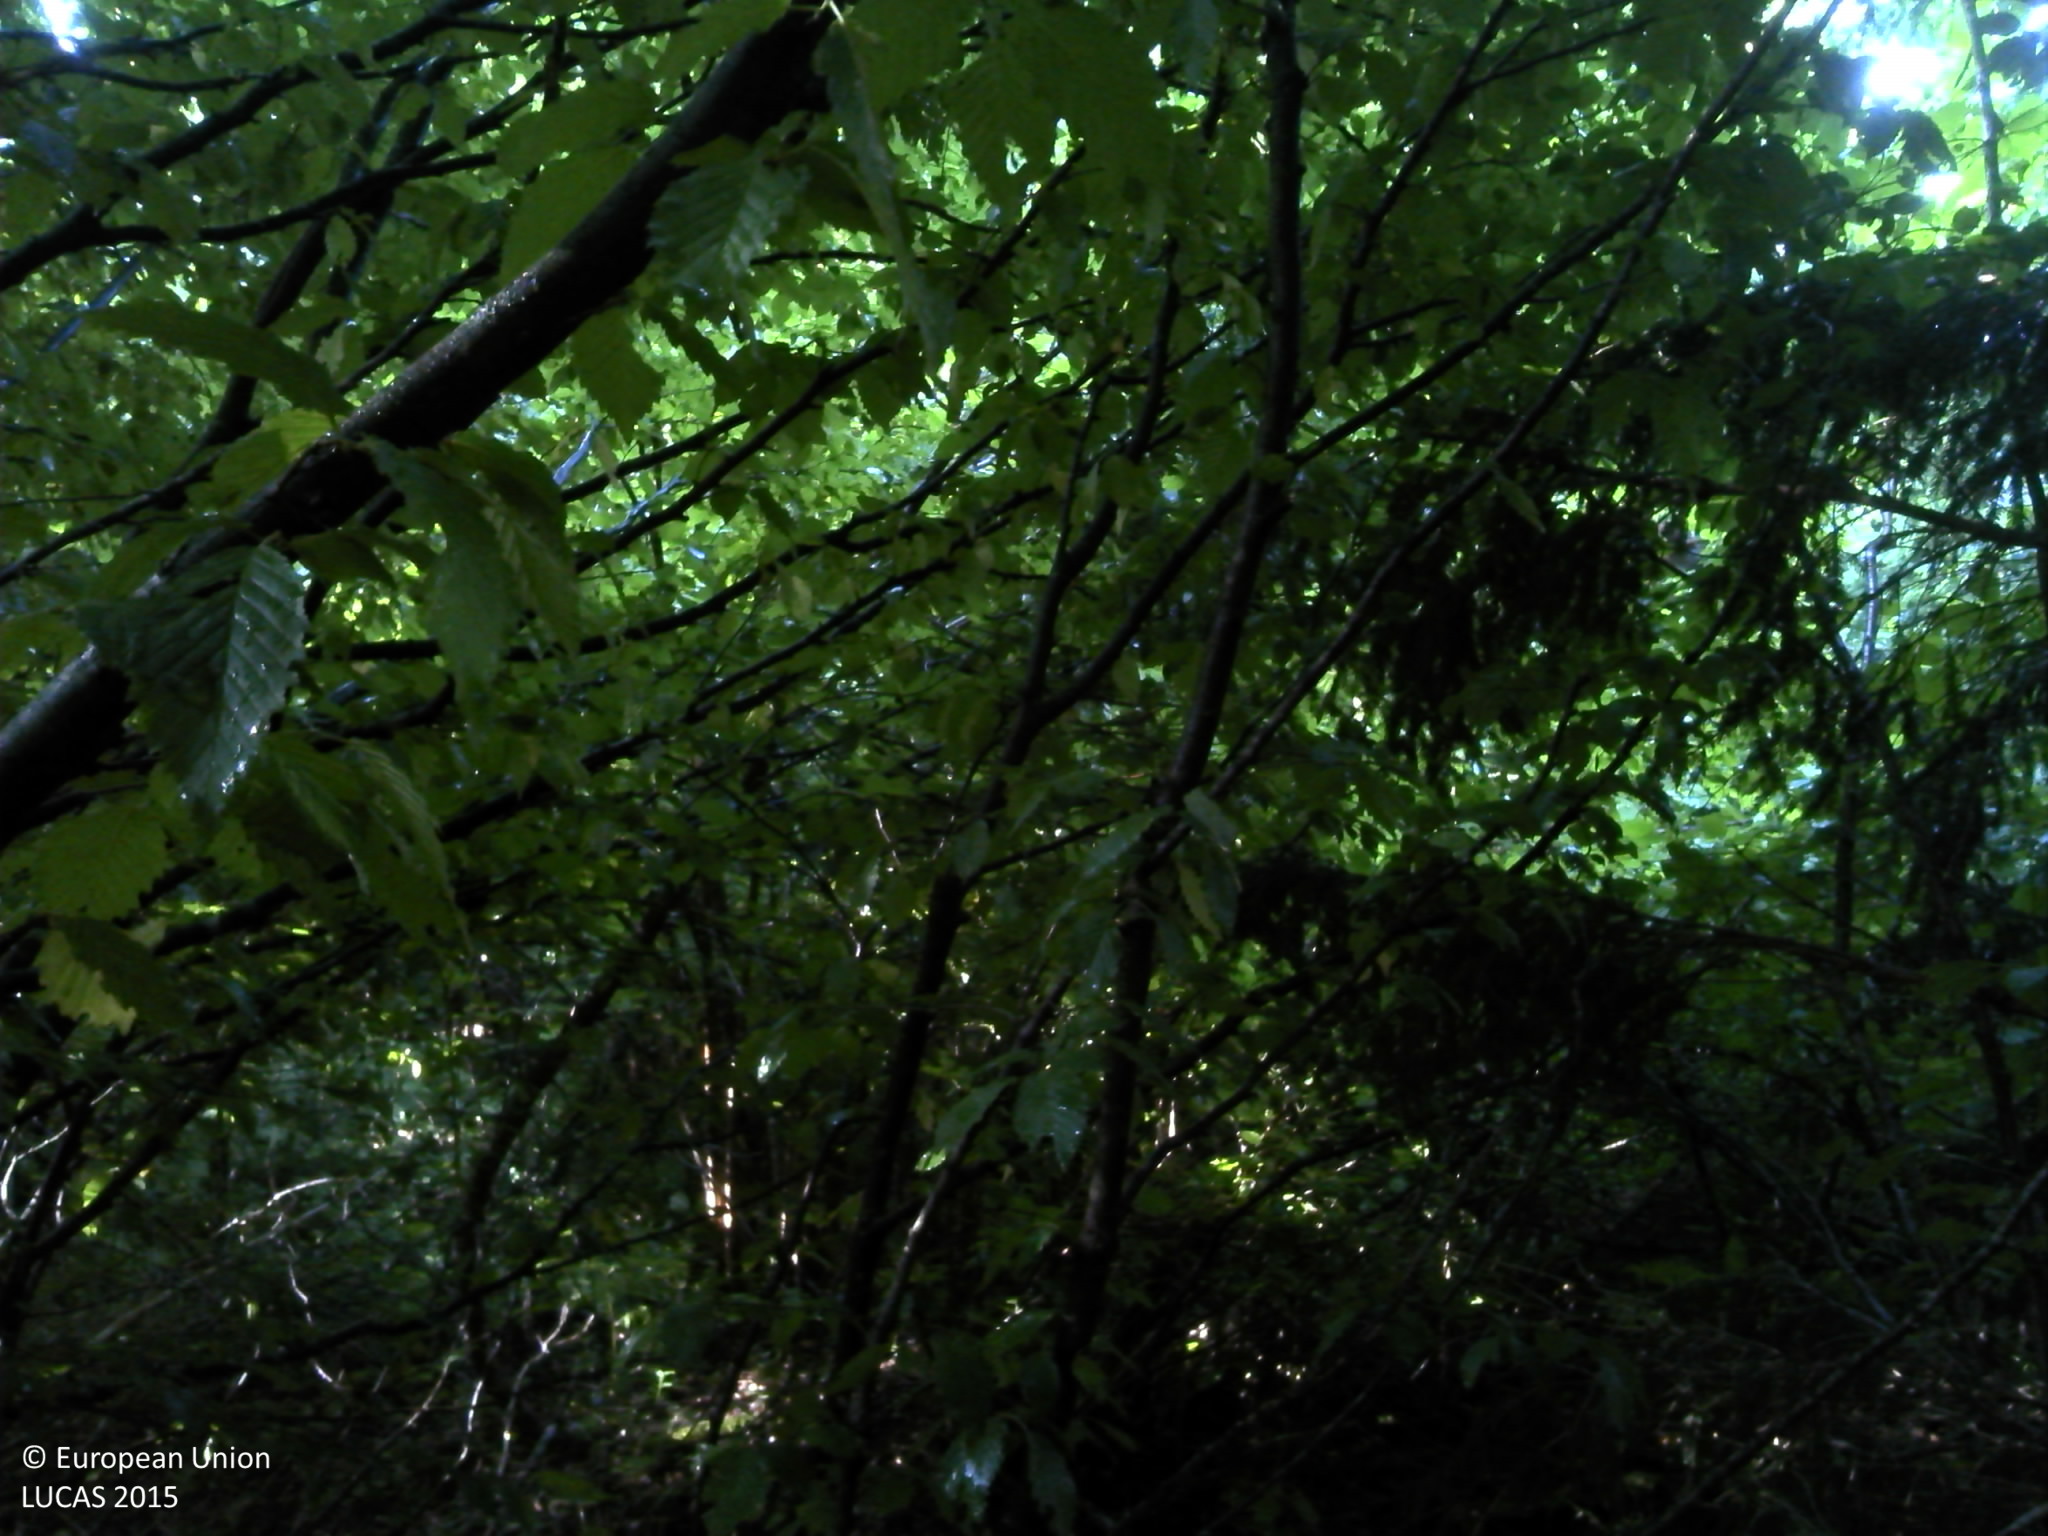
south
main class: Woodland
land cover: Spruce dominated mixed woodland
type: hemiboreal forest and nemoral coniferous forest and mixed broadleaved-coniferous forest
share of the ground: > 75 %
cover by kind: coniferous forest trees 75 %, broadleaved forest trees 25 %
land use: Semi-natural and natural areas not in use
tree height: > 5 m
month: June
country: HR
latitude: 44.7754
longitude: 15.6429
